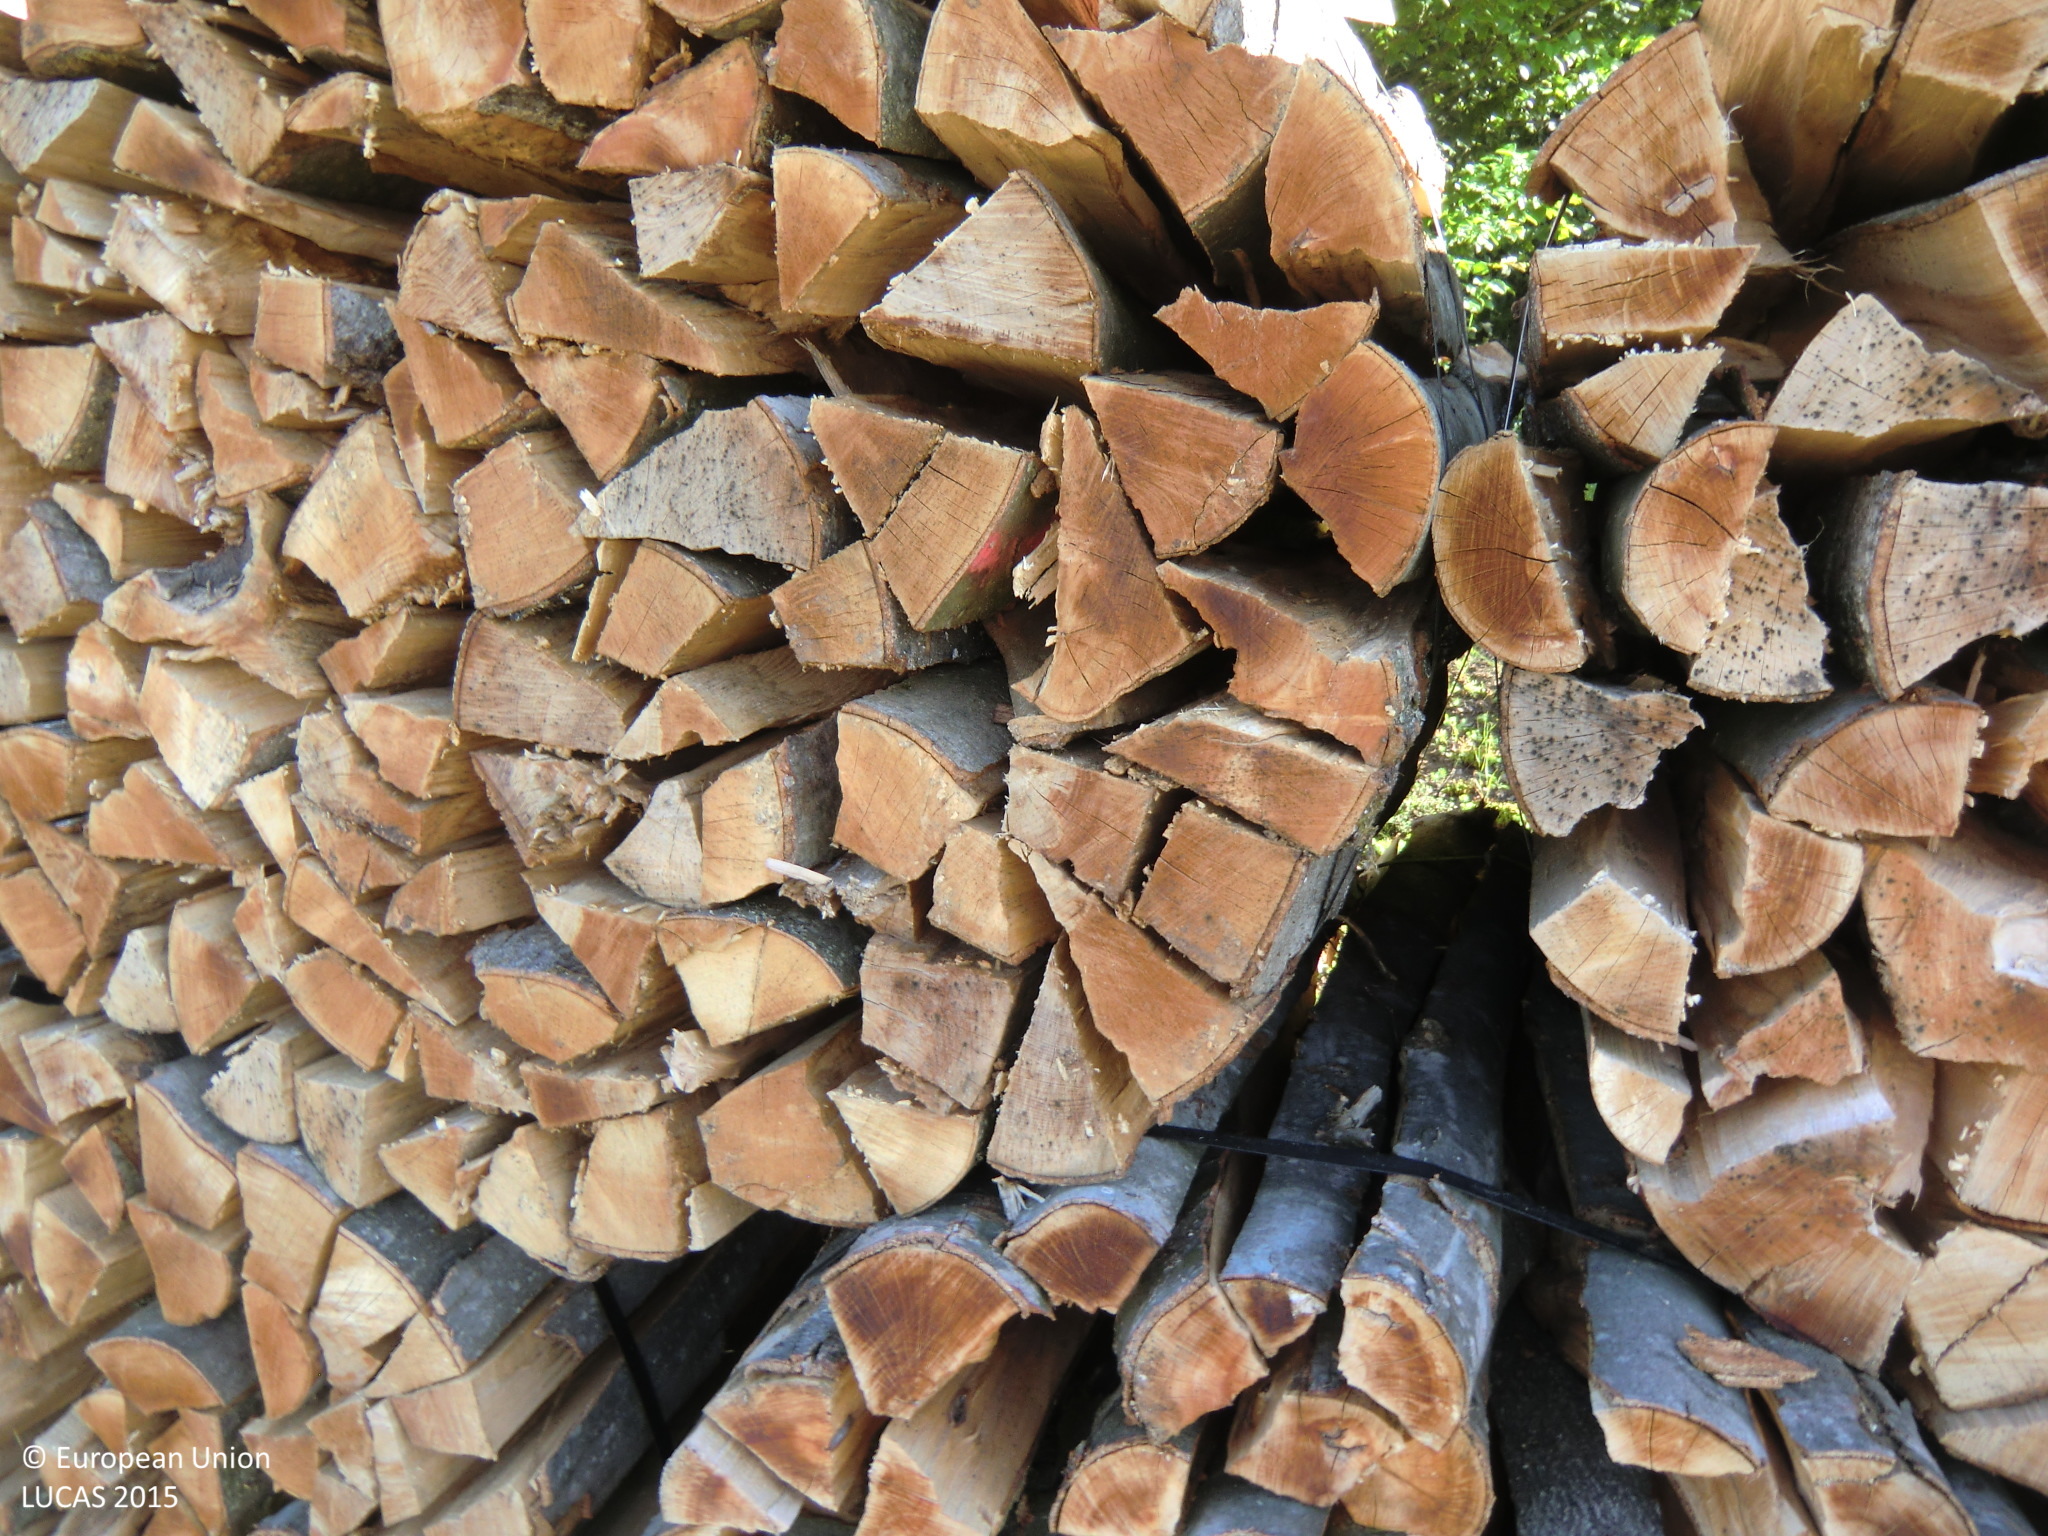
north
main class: Grassland
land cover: Grassland without tree/shrub cover
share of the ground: > 75 %
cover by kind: herbaceous plants 100 %
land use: Agriculture (excluding fallow land and kitchen gardens)
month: June
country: AT
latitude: 48.2736
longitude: 14.9731
